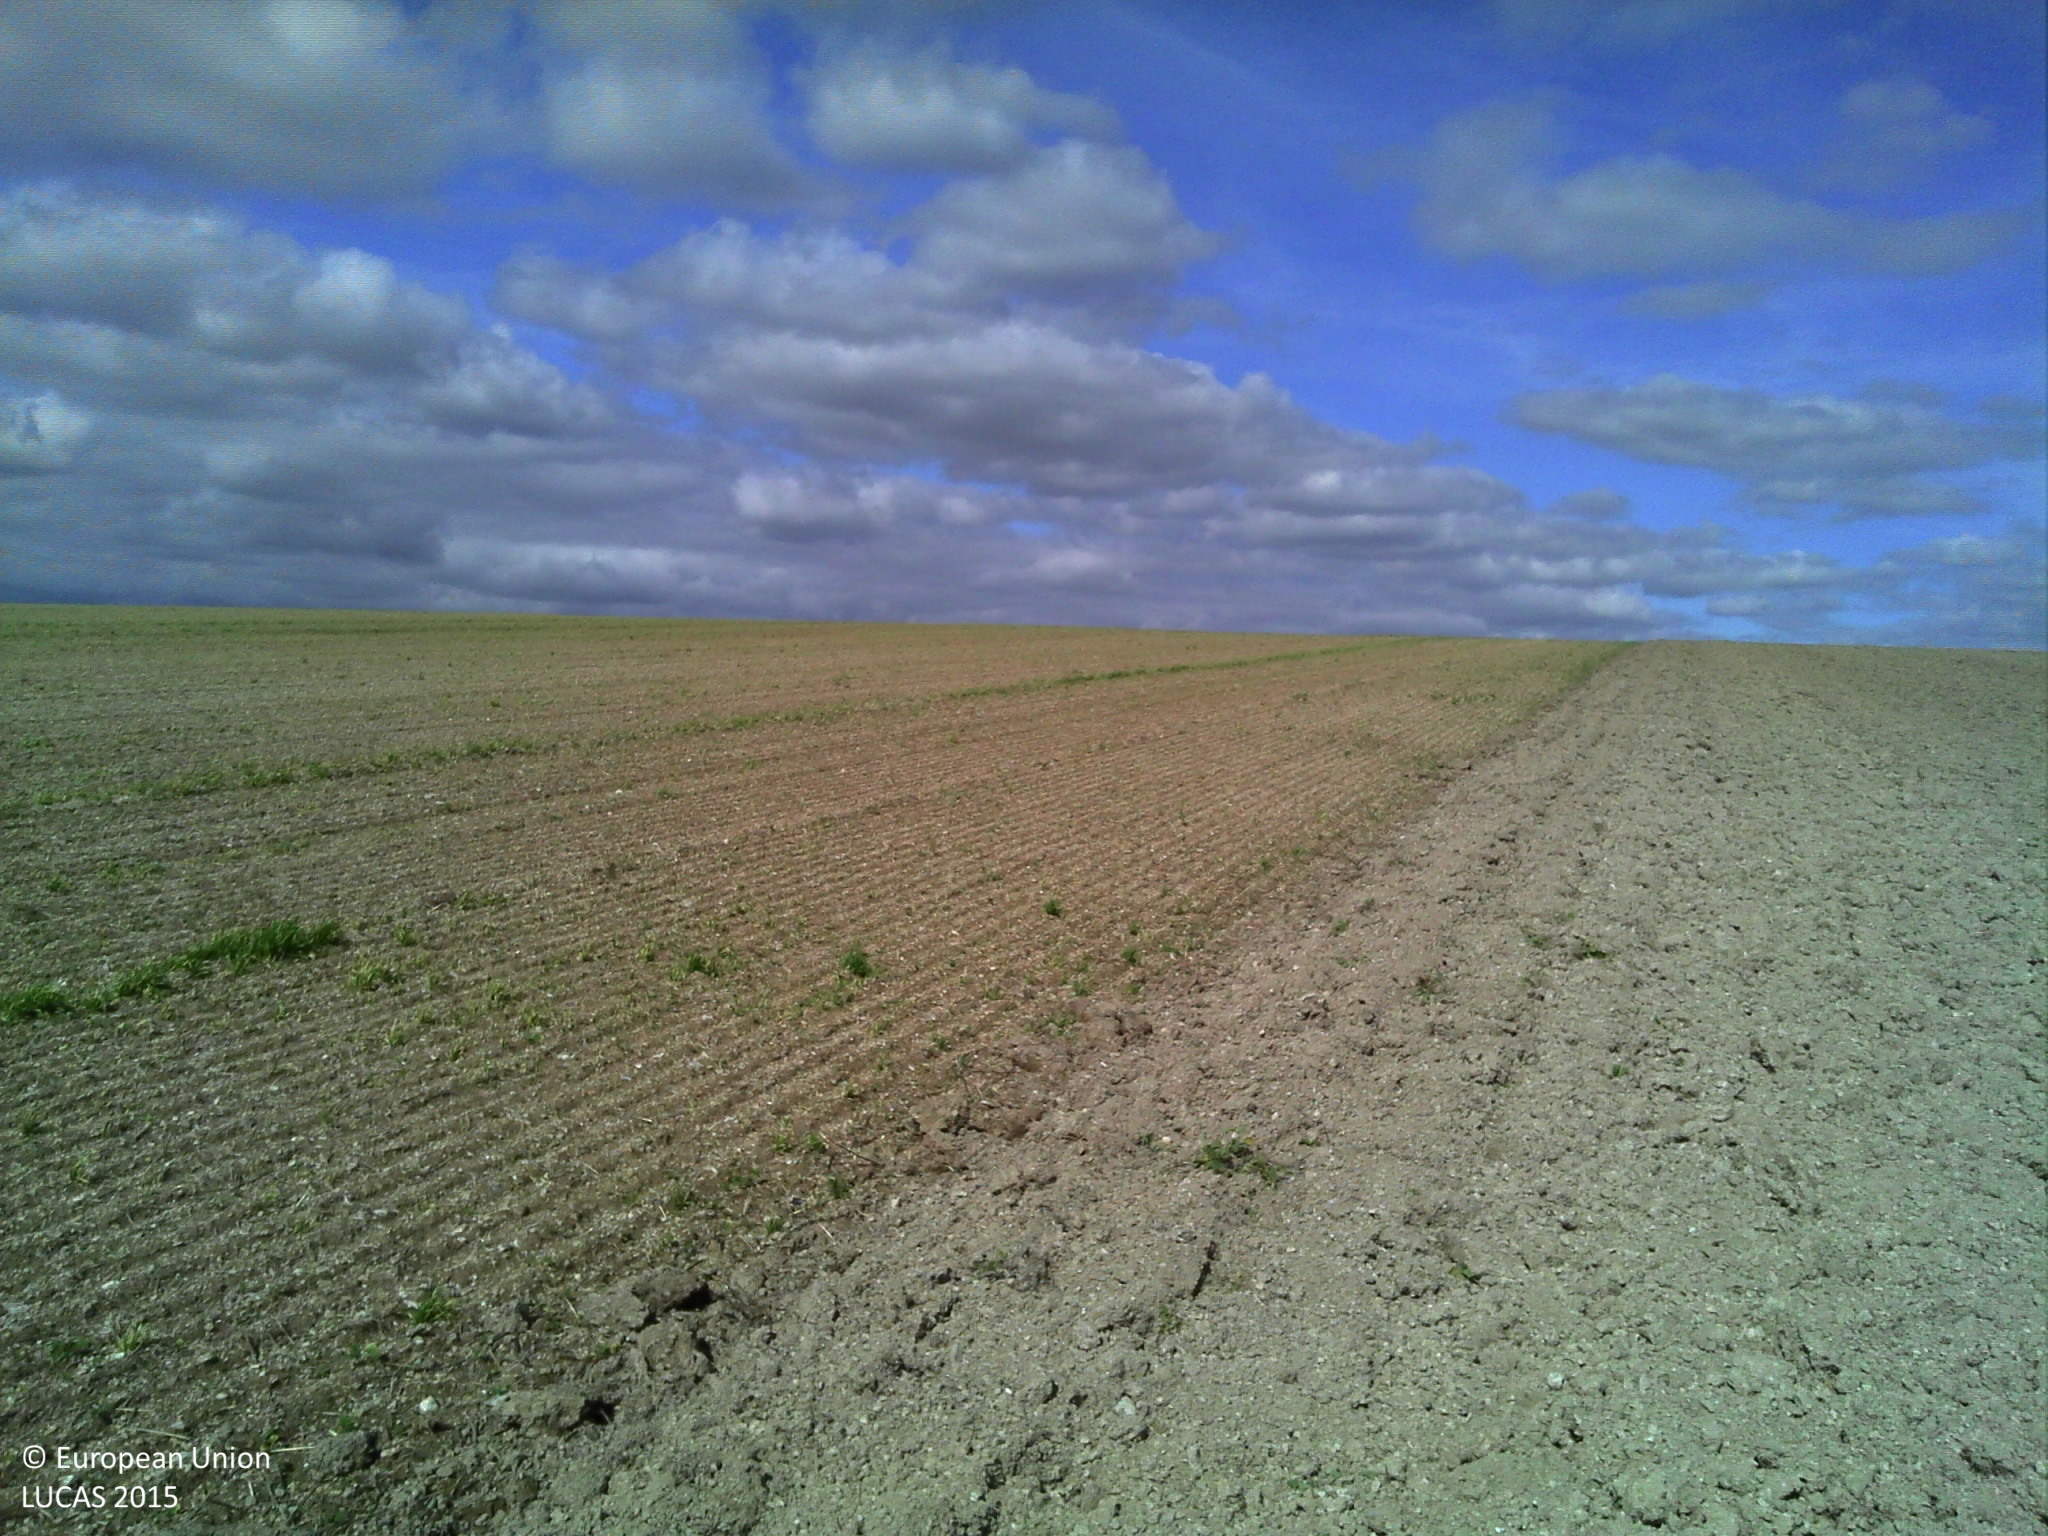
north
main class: Cropland
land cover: Rape and turnip rape
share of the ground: < 10 %
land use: Agriculture (excluding fallow land and kitchen gardens)
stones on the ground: < 10 %
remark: Tilled/Sowed
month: September
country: FR
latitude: 48.3036
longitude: 3.8344
